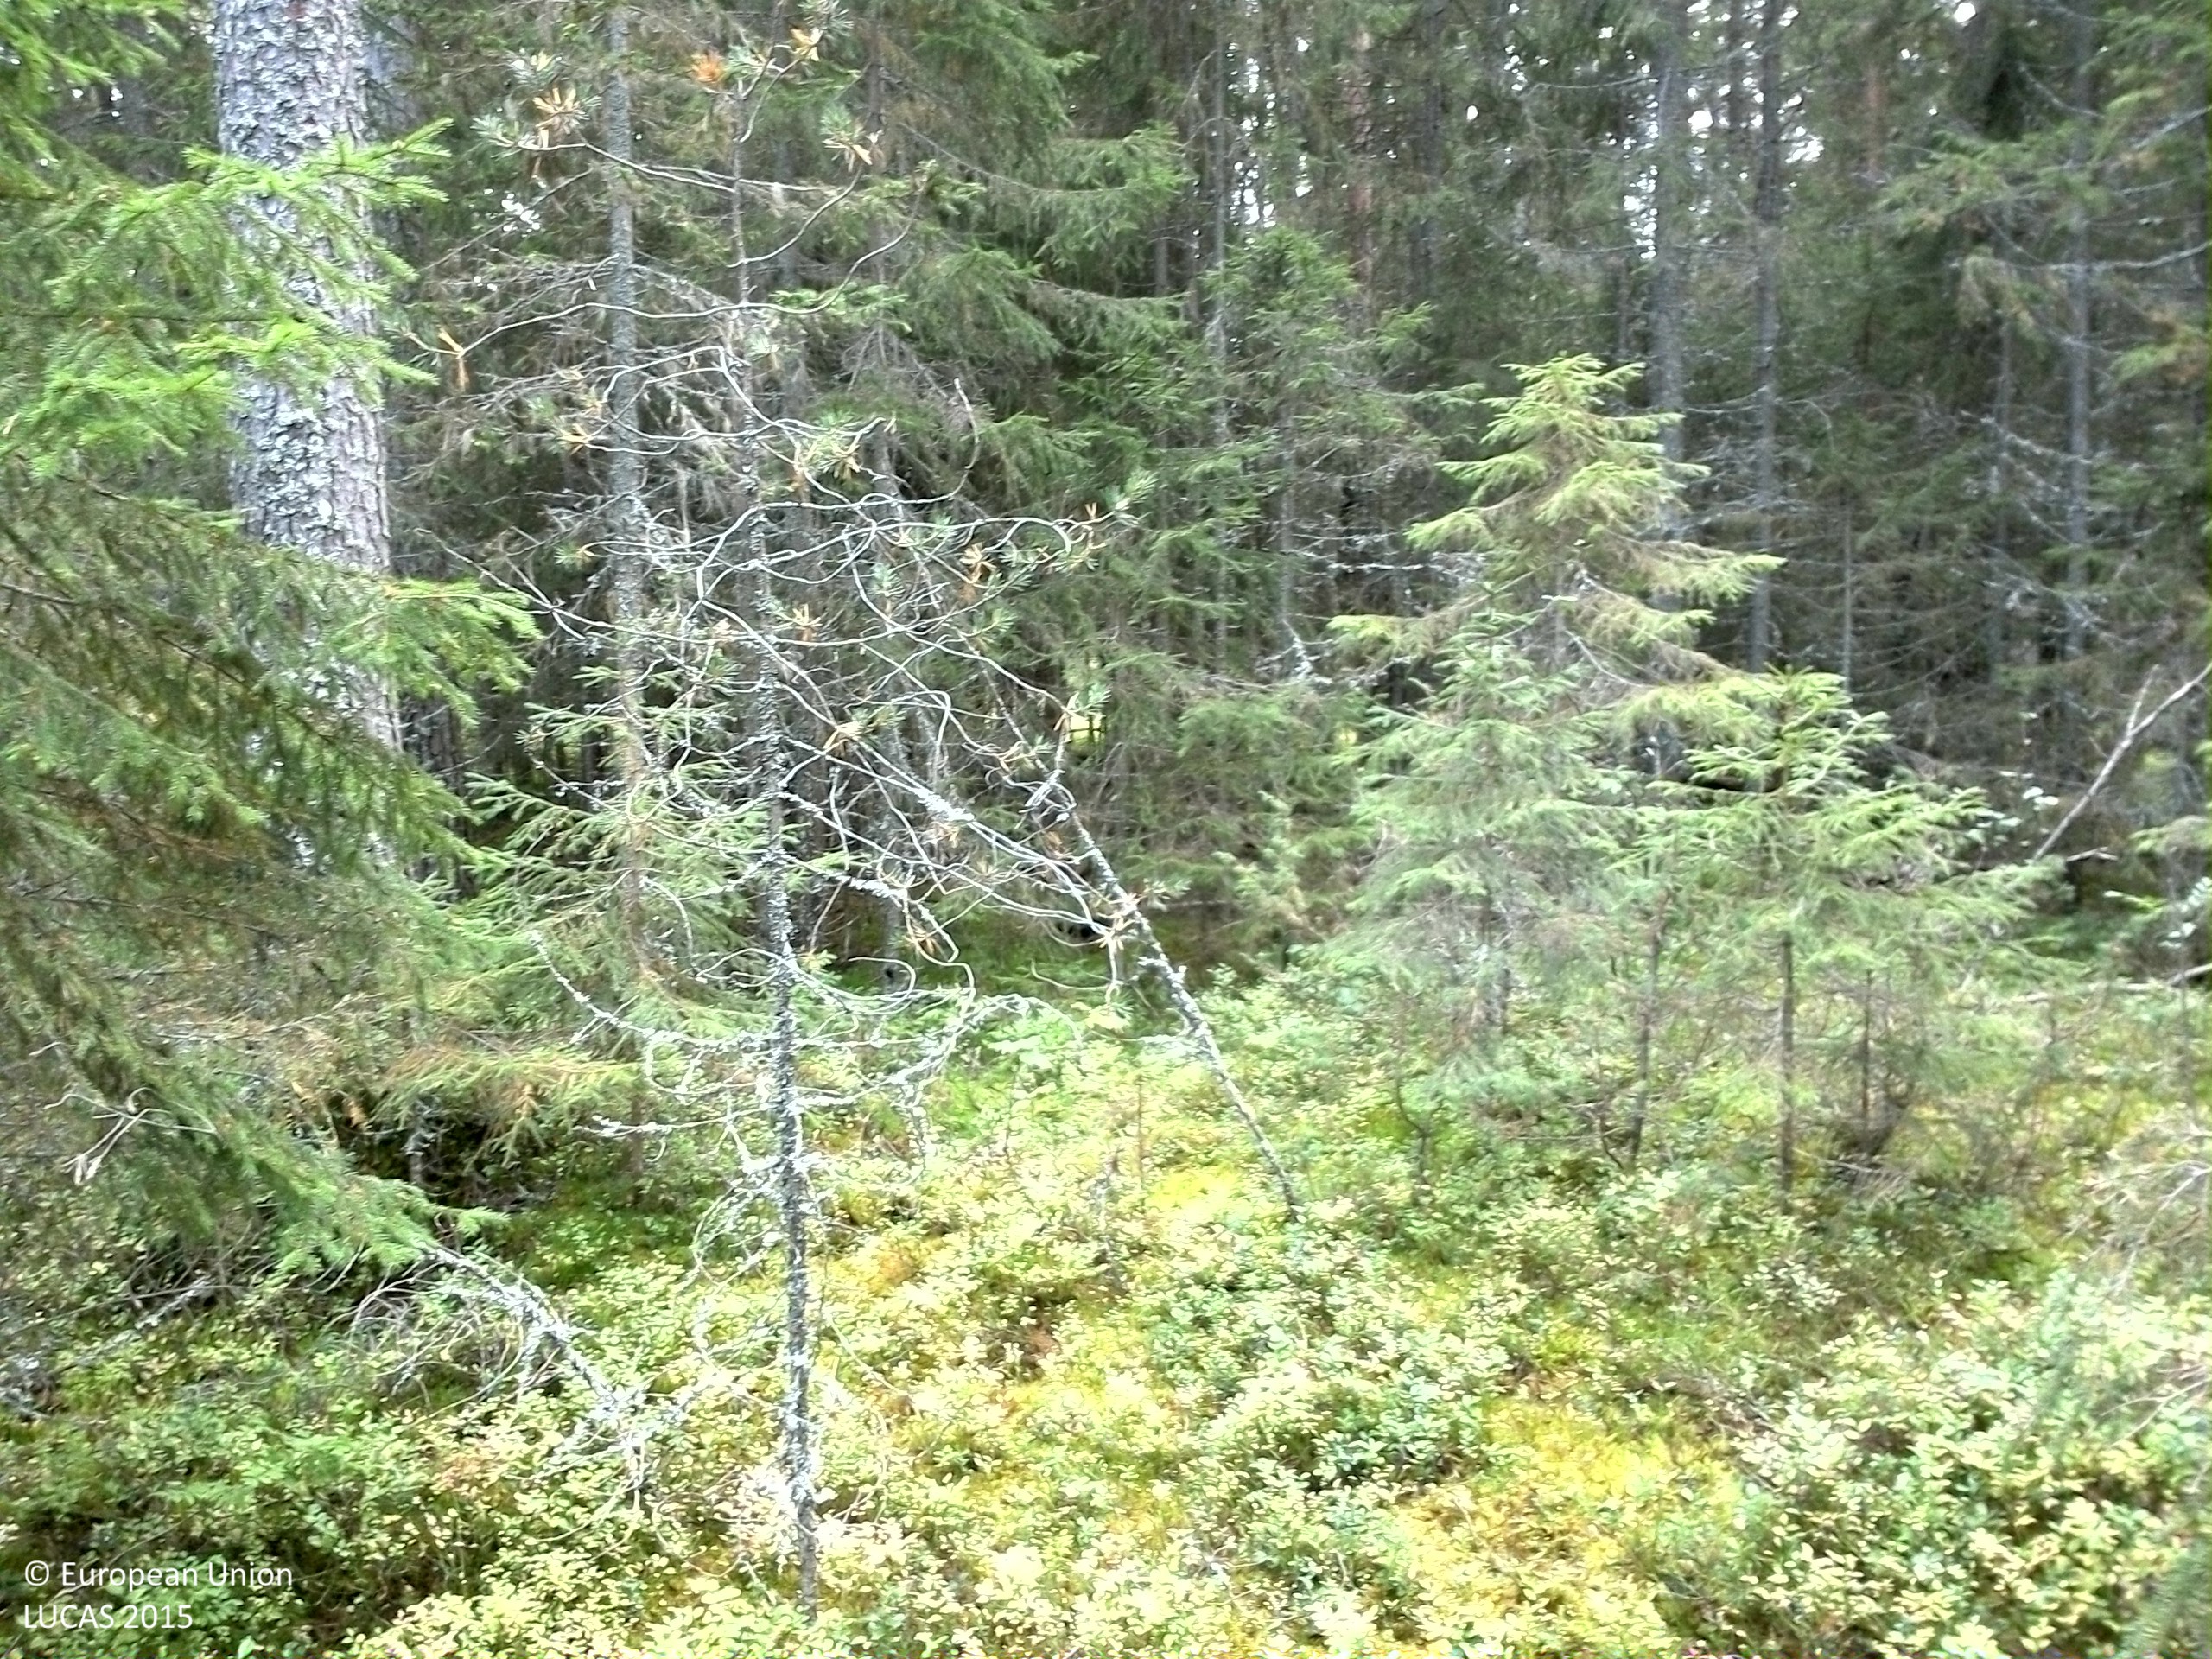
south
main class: Woodland
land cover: Other coniferous woodland
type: boreal forest
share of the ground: 50 - 75 %
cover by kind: coniferous forest trees 65 %, shrubs 30 %, lichens and mosses 5 %
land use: Forestry
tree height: > 5 m
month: September
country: SE
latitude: 61.3223
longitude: 15.4207
